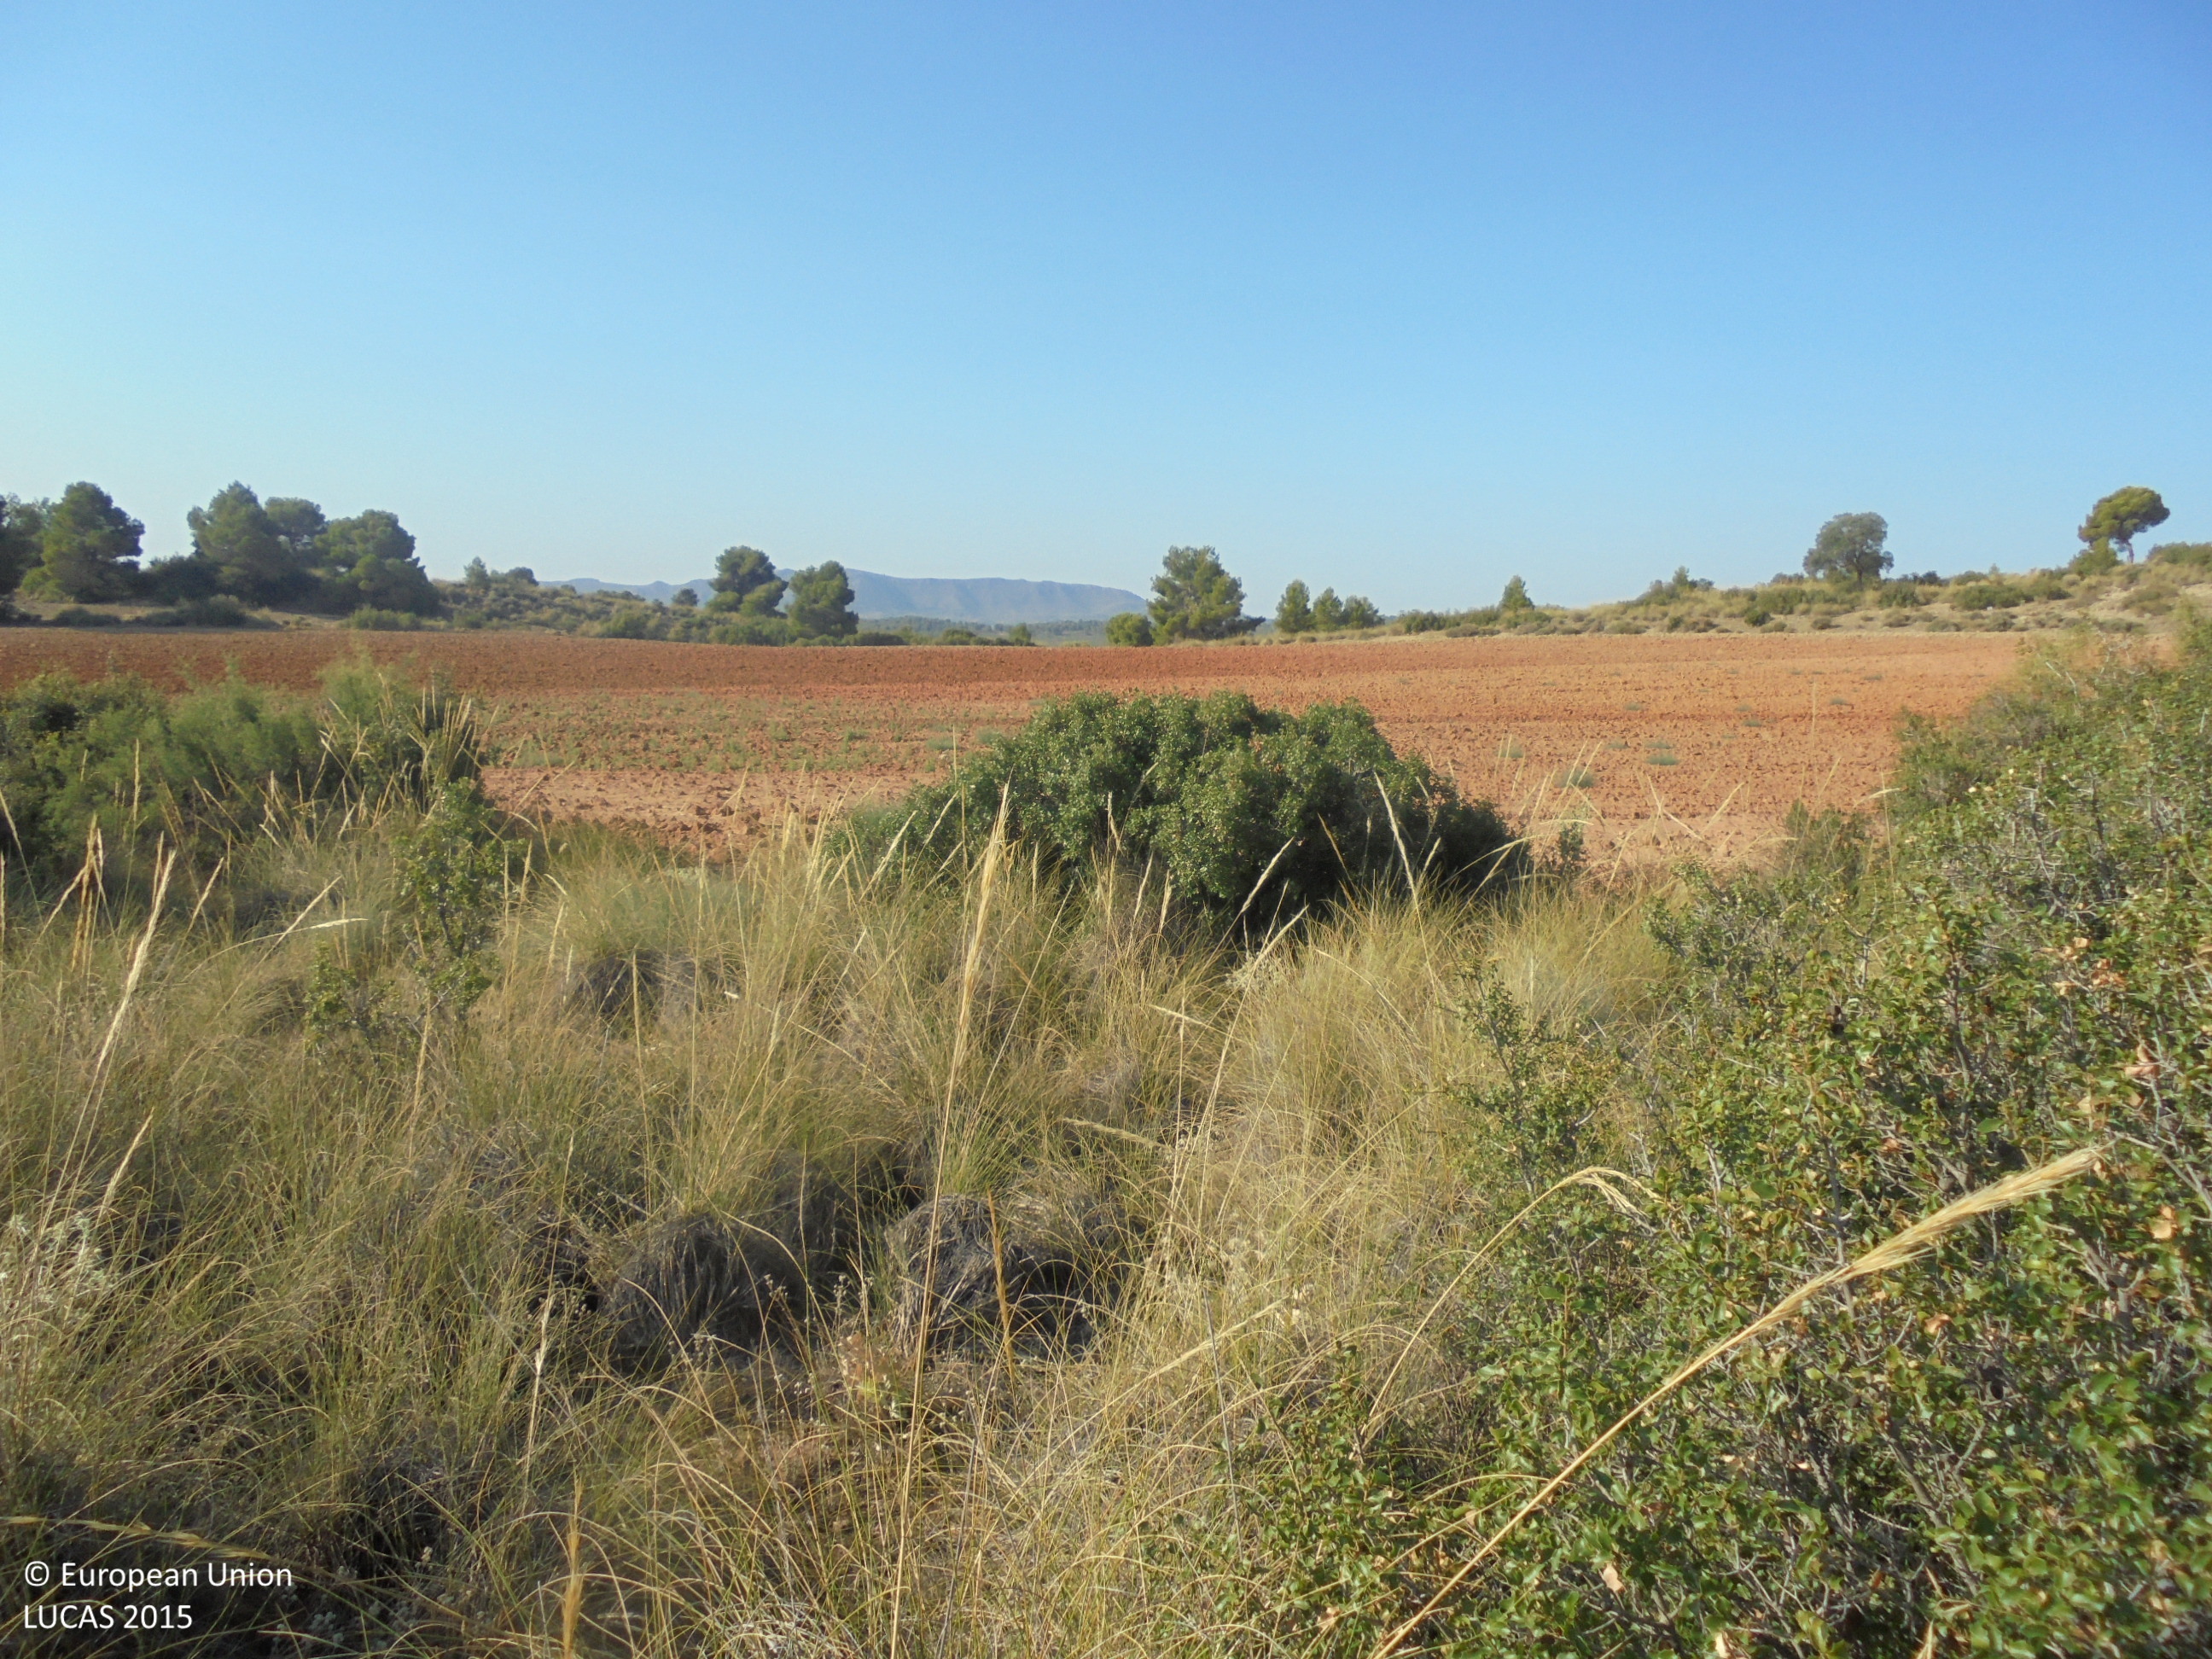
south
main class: Shrubland
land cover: Shrubland with sparse tree cover
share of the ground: > 75 %
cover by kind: shrubs 80 %, unconsolidated bare surface 15 %, coniferous forest trees 5 %
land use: Semi-natural and natural areas not in use
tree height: < 5 m
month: July
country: ES
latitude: 38.7056
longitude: -1.5515
